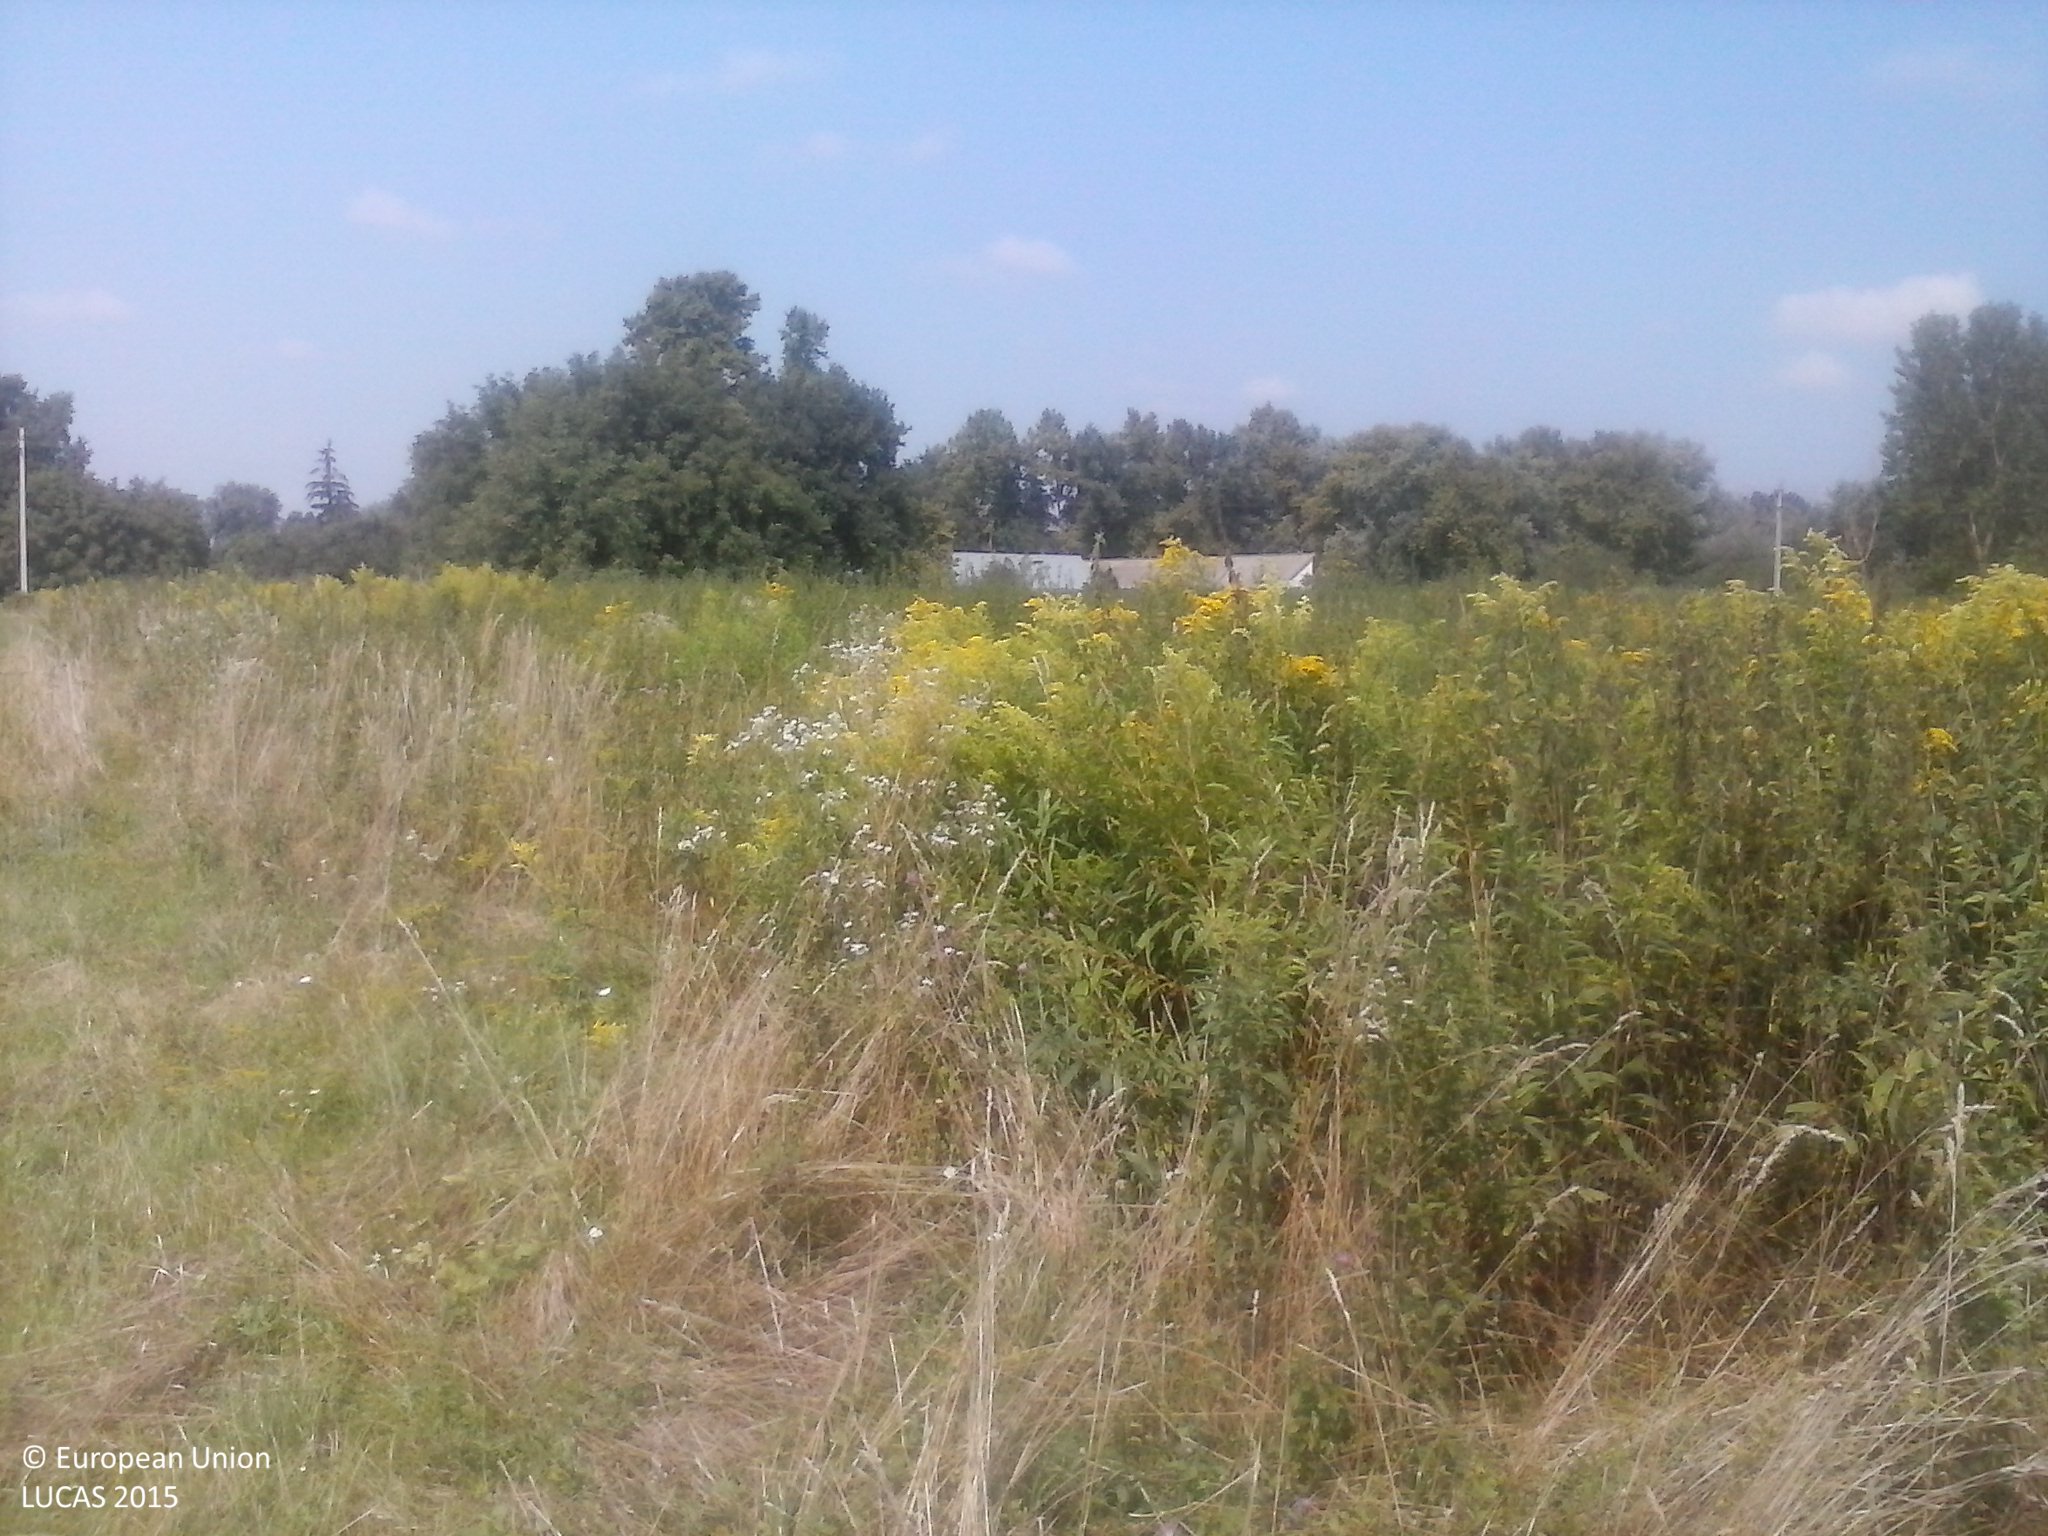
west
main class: Grassland
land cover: Grassland without tree/shrub cover
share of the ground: > 75 %
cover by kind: herbaceous plants 100 %
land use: Agriculture (excluding fallow land and kitchen gardens)
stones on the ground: < 10 %
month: August
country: HU
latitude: 45.8870
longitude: 17.7745
